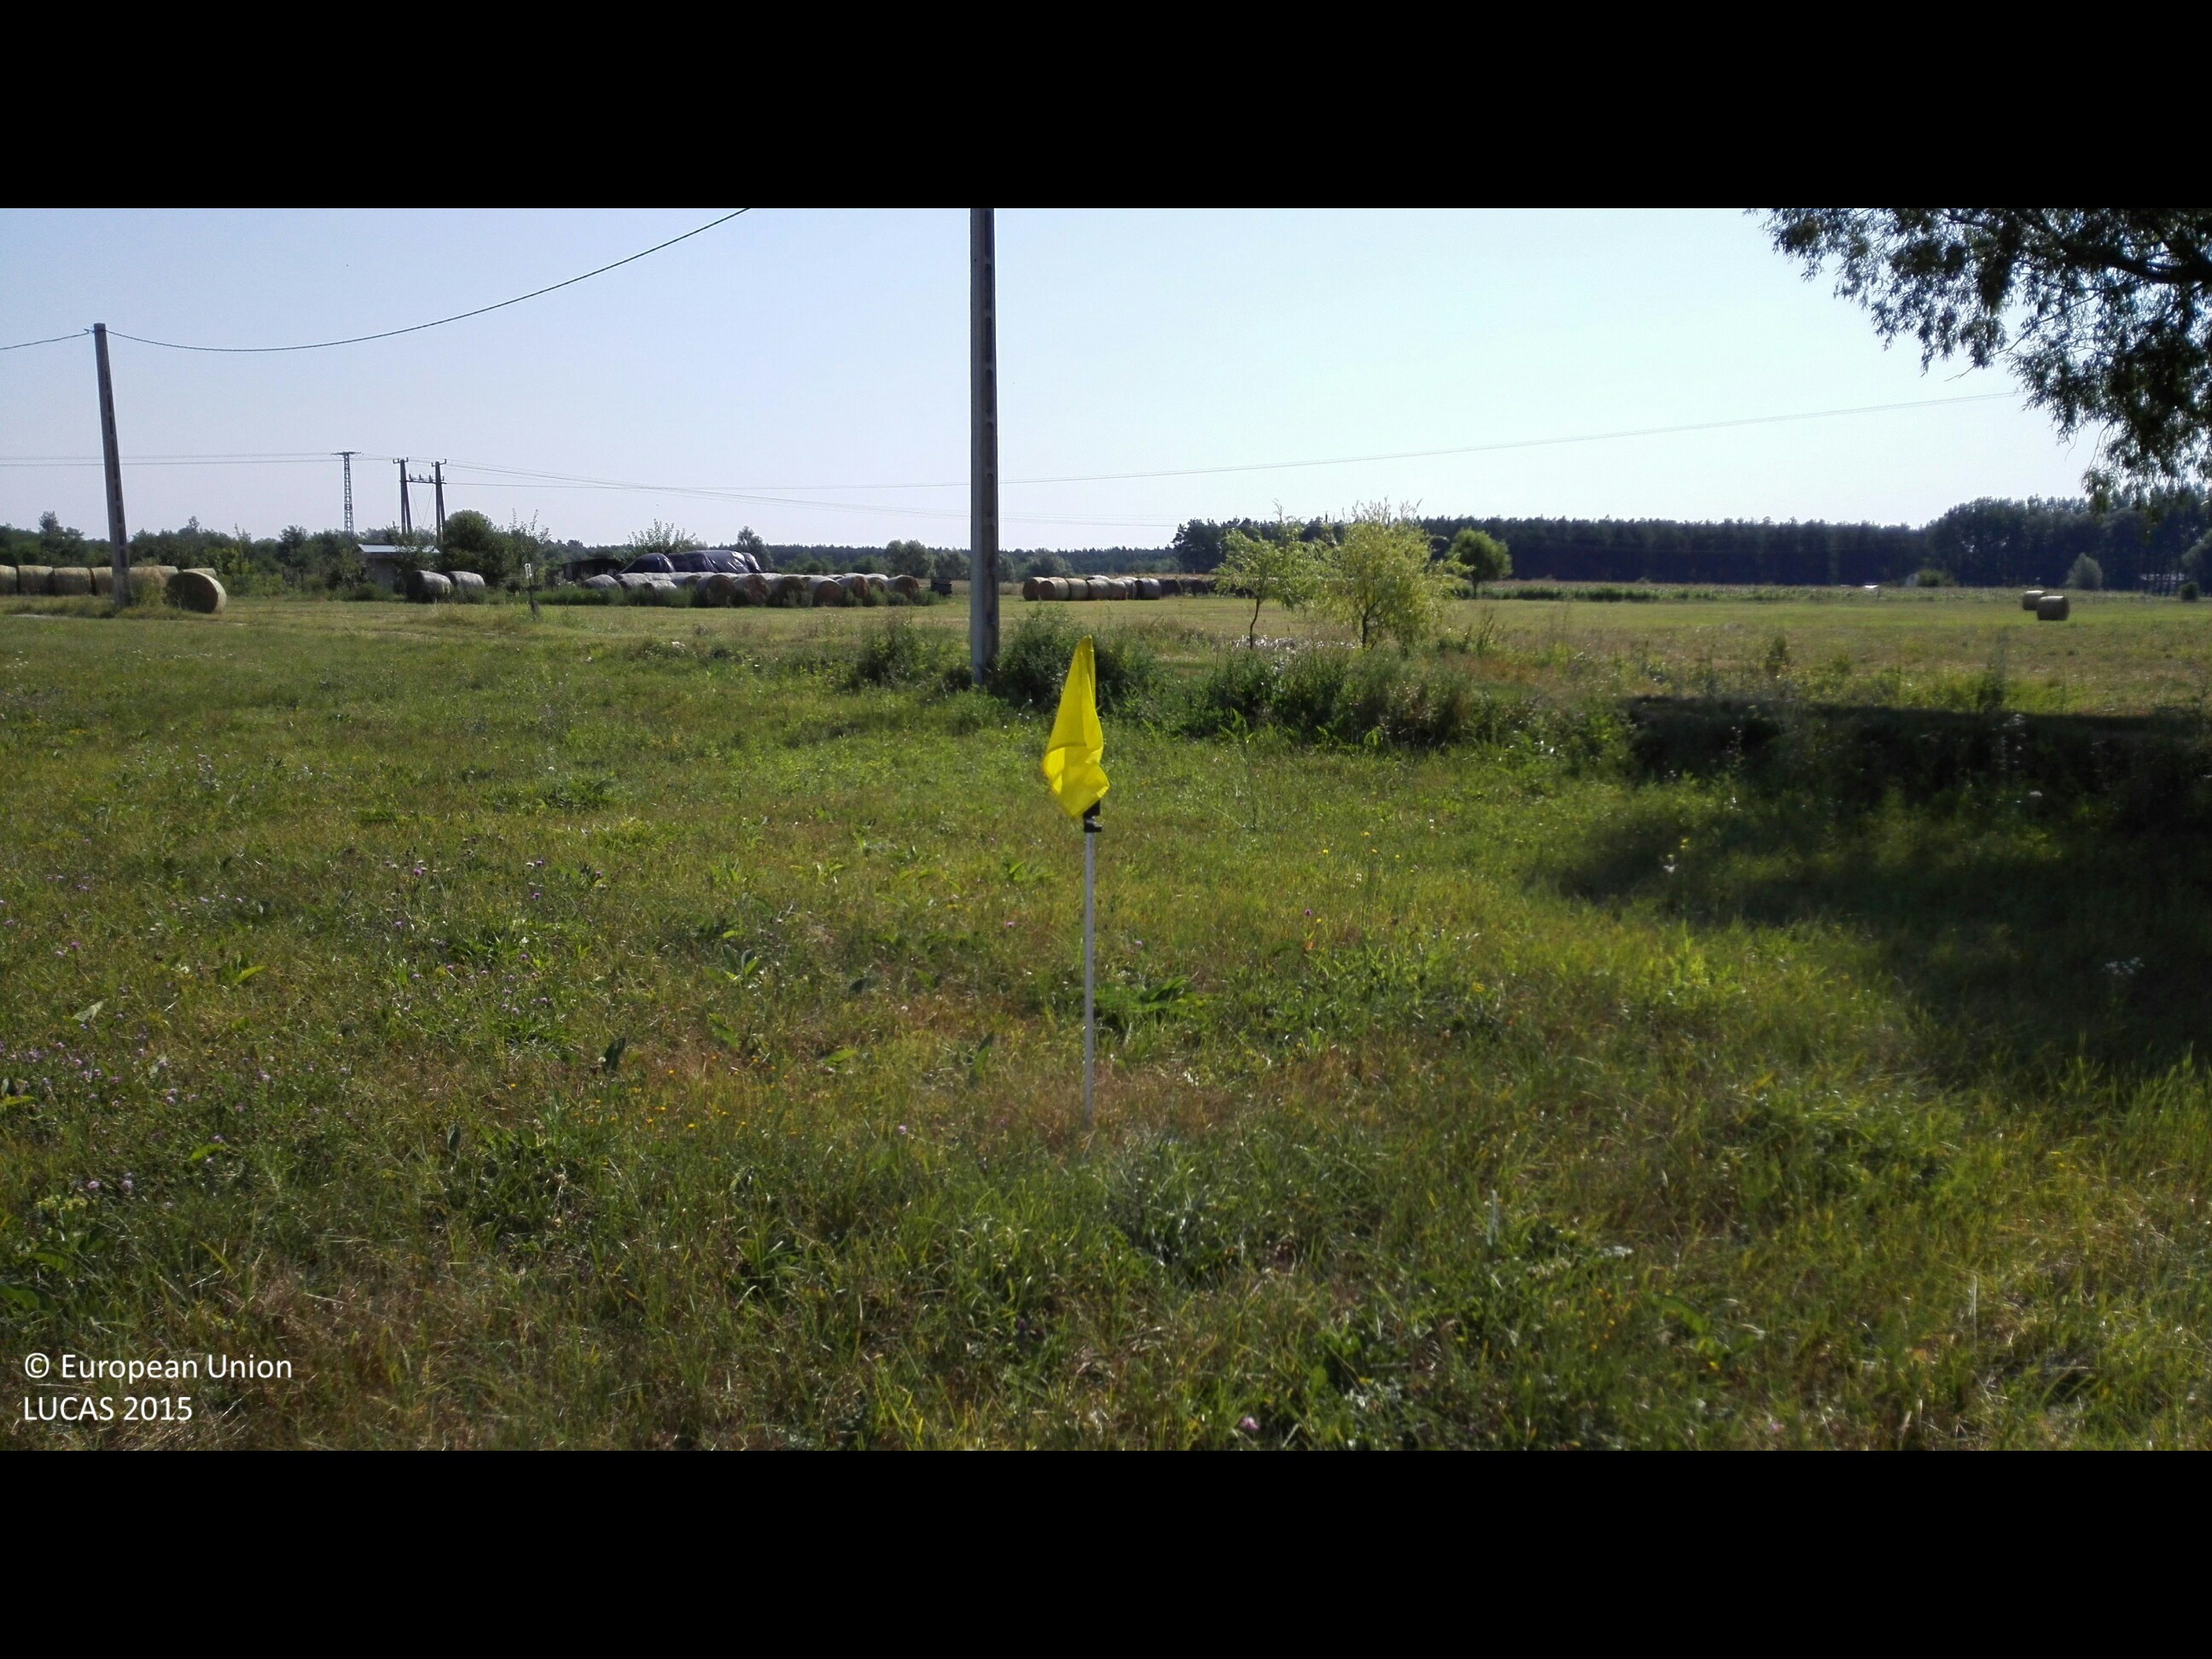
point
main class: Grassland
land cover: Grassland without tree/shrub cover
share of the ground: > 75 %
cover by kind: herbaceous plants 100 %
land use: Agriculture (excluding fallow land and kitchen gardens)
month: August
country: HU
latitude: 47.4672
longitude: 21.7339
